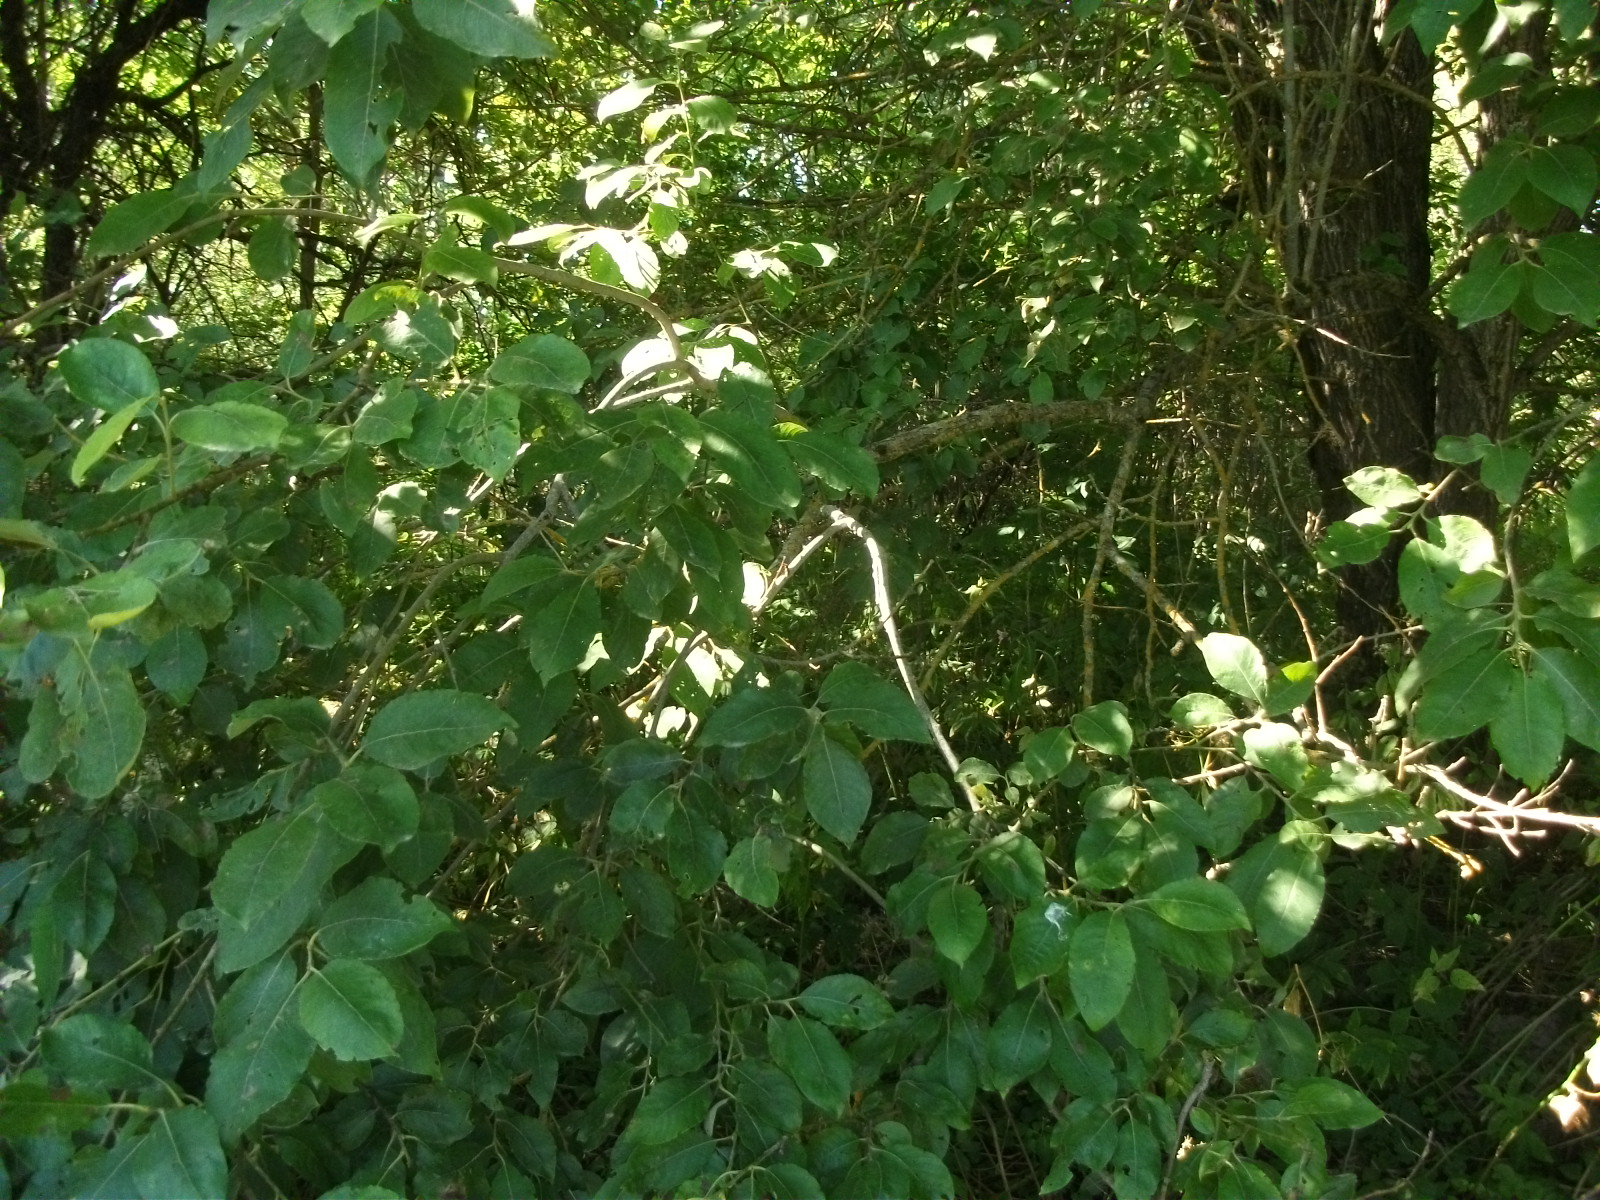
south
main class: Woodland
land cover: Broadleaved woodland
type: non-riverine alder, birch or aspen forest
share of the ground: 50 - 75 %
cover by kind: broadleaved forest trees 60 %, shrubs 20 %, herbaceous plants 20 %
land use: Abandoned areas
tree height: < 5 m
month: August
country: LV
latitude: 56.2619
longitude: 26.4033
